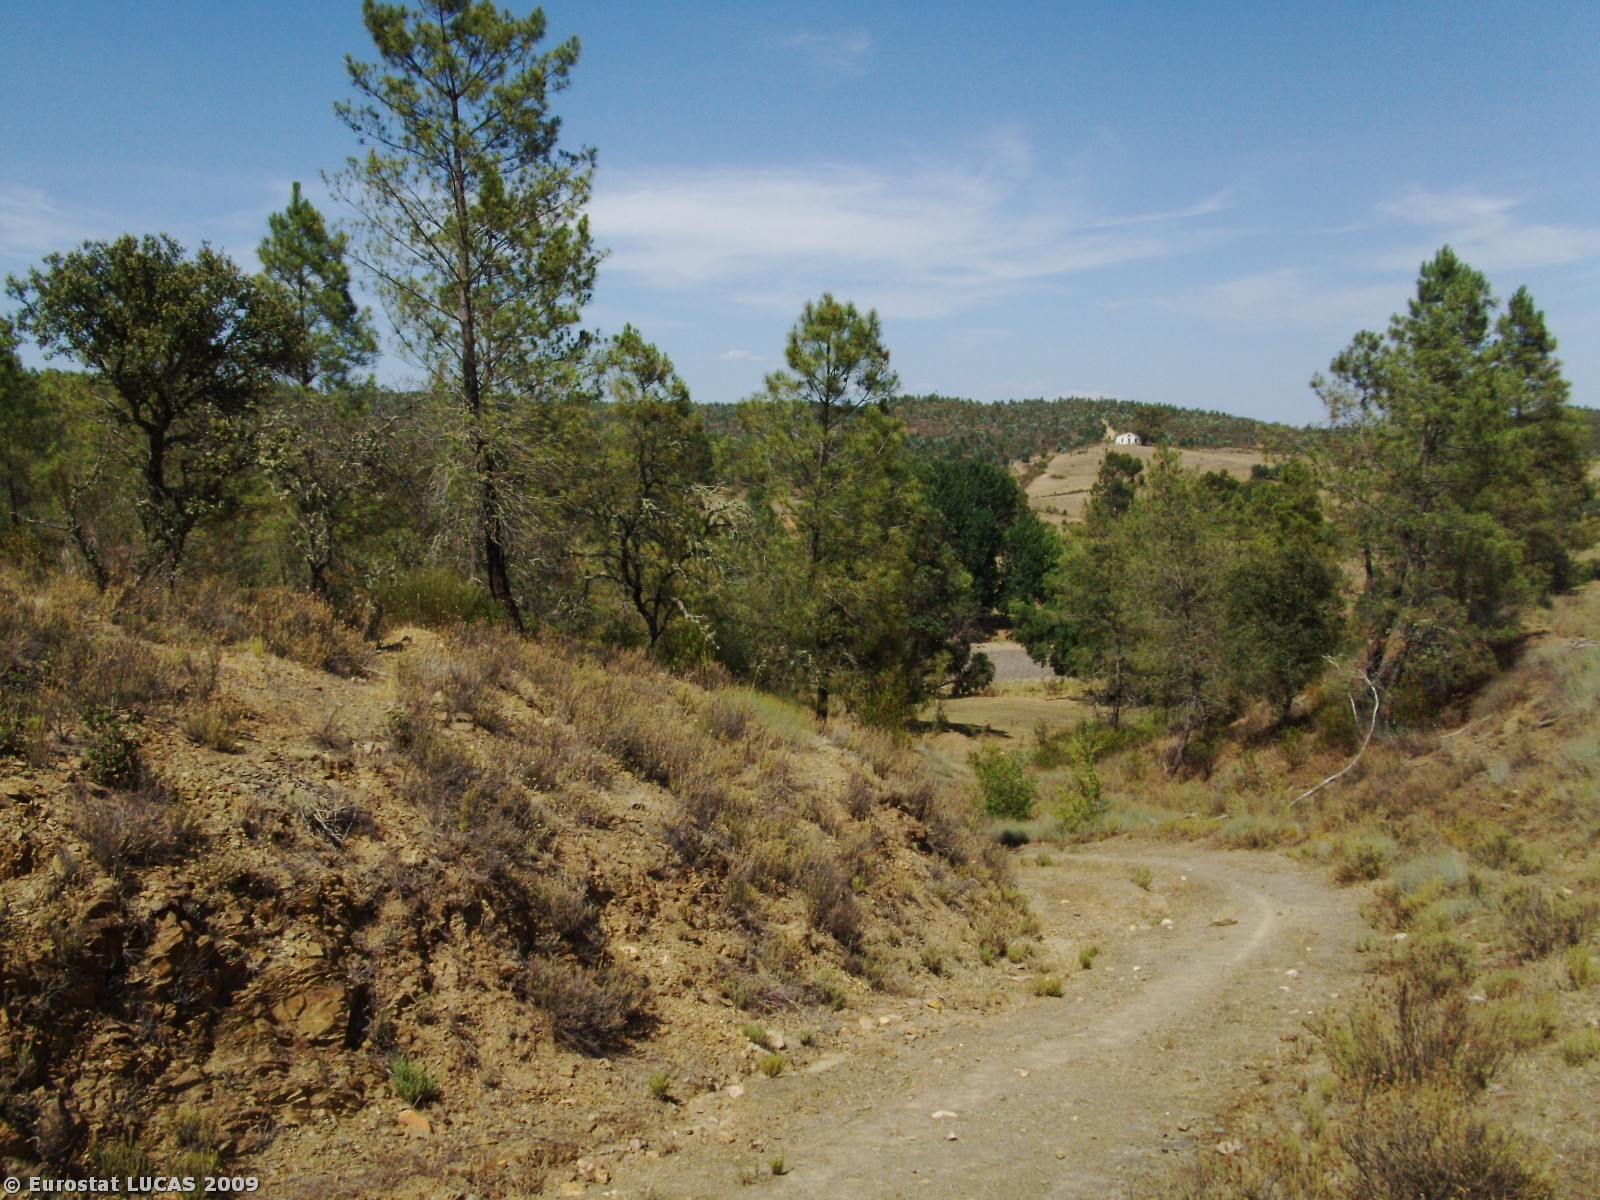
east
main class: Shrubland
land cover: Shrubland with sparse tree cover
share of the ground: 50 - 75 %
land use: Unused
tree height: > 5 m
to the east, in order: Shrubland with sparse tree cover; Broadleaved woodland; Tracks; Broadleaved woodland; Spontaneously vegetated surfaces; Broadleaved woodland; Inland running water
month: July
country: PT
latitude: 40.0278
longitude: -6.8802
